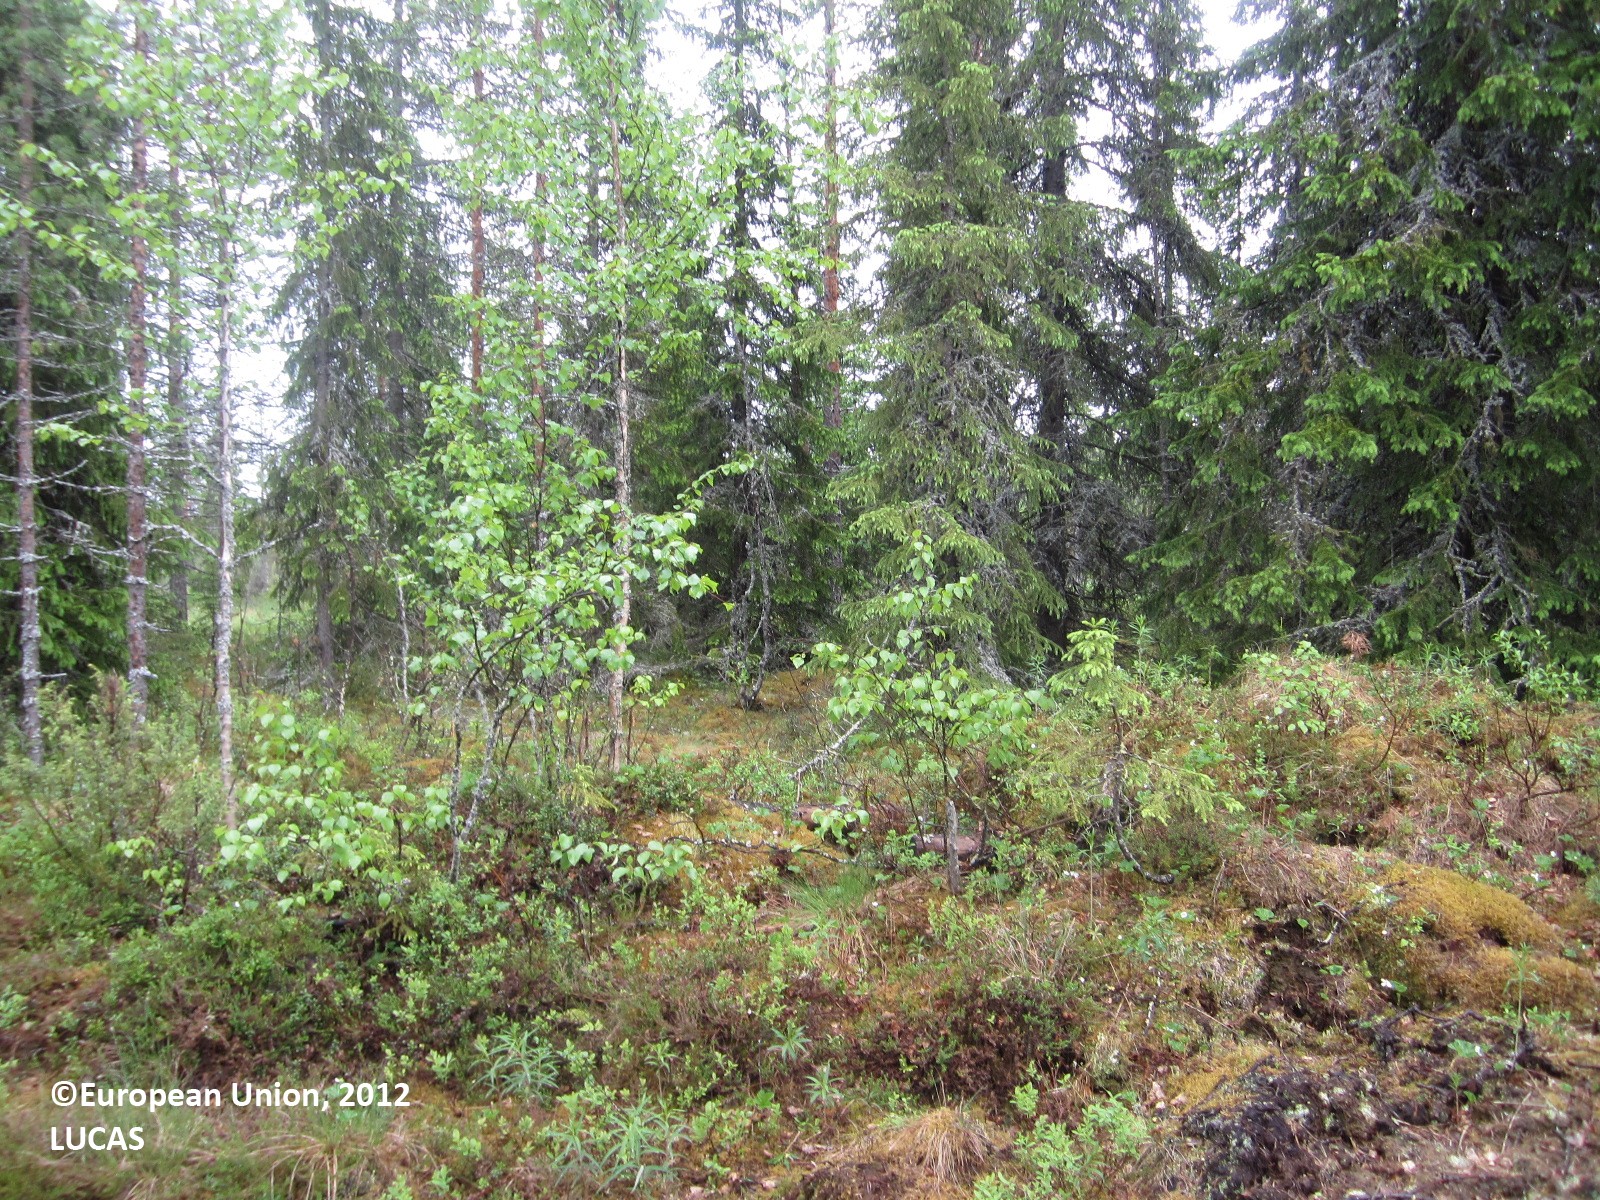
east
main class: Woodland
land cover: Other coniferous woodland
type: boreal forest
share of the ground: > 75 %
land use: Forestry
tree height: > 5 m
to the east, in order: Other coniferous woodland; Pine dominated coniferous woodland; Ditches and canals; Grass margins; Spruce dominated coniferous woodland; Spontaneously vegetated surfaces; Ditches and canals; Spontaneously vegetated surfaces; Paved roads, cycling and walking lanes; Spontaneously vegetated surfaces; Ditches and canals; Spontaneously vegetated surfaces; Pine dominated coniferous woodland; Ditches and canals; Pine dominated coniferous woodland; Spontaneously vegetated surfaces; Ditches and canals; Shrubland with sparse tree cover; Ditches and canals; Shrubland with sparse tree cover; Ditches and canals; Pine dominated coniferous woodland; Ditches and canals; Pine dominated mixed woodland; Ditches and canals; Pine dominated coniferous woodland
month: June
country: FI
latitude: 64.6667
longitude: 29.8080
